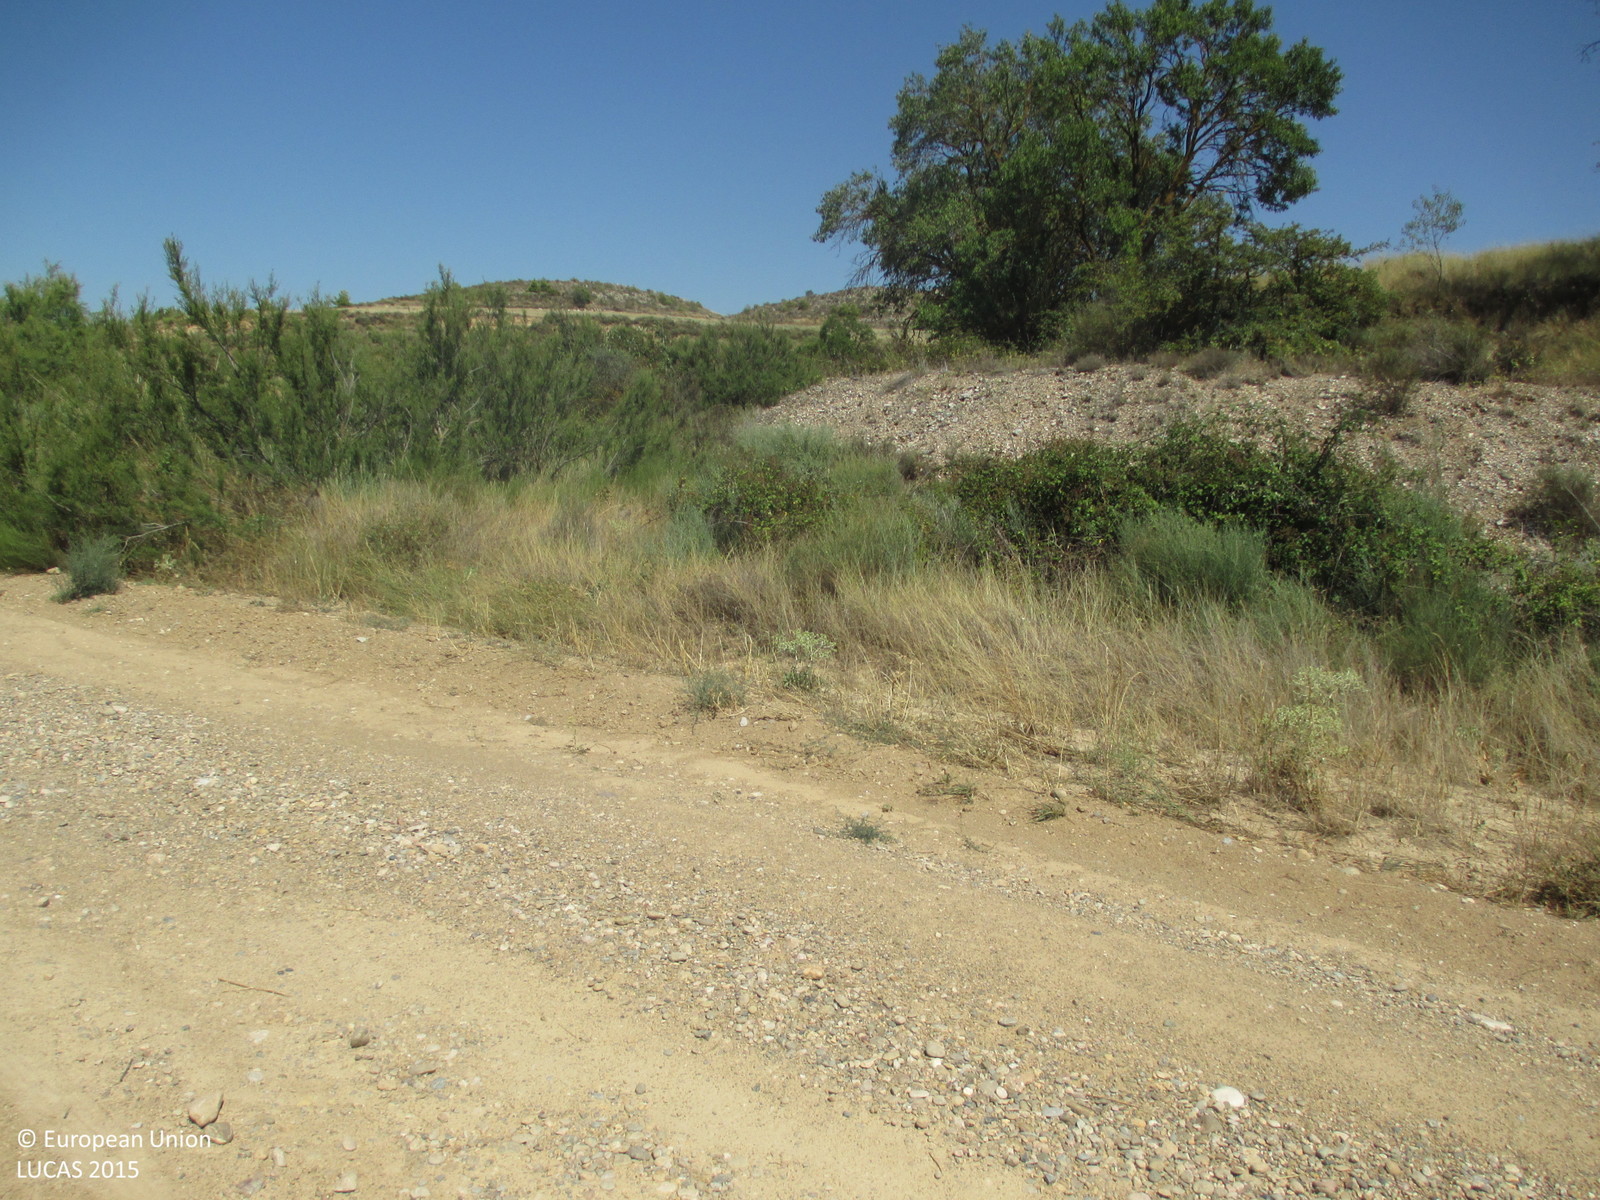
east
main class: Shrubland
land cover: Shrubland without tree cover
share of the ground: > 75 %
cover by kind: shrubs 90 %, unconsolidated bare surface 10 %
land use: Semi-natural and natural areas not in use
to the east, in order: Shrubland without tree cover; Tracks; Shrubland without tree cover; Barley; Shrubland with sparse tree cover; Barley; Shrubland without tree cover
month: July
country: ES
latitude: 41.9329
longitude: 0.2993
